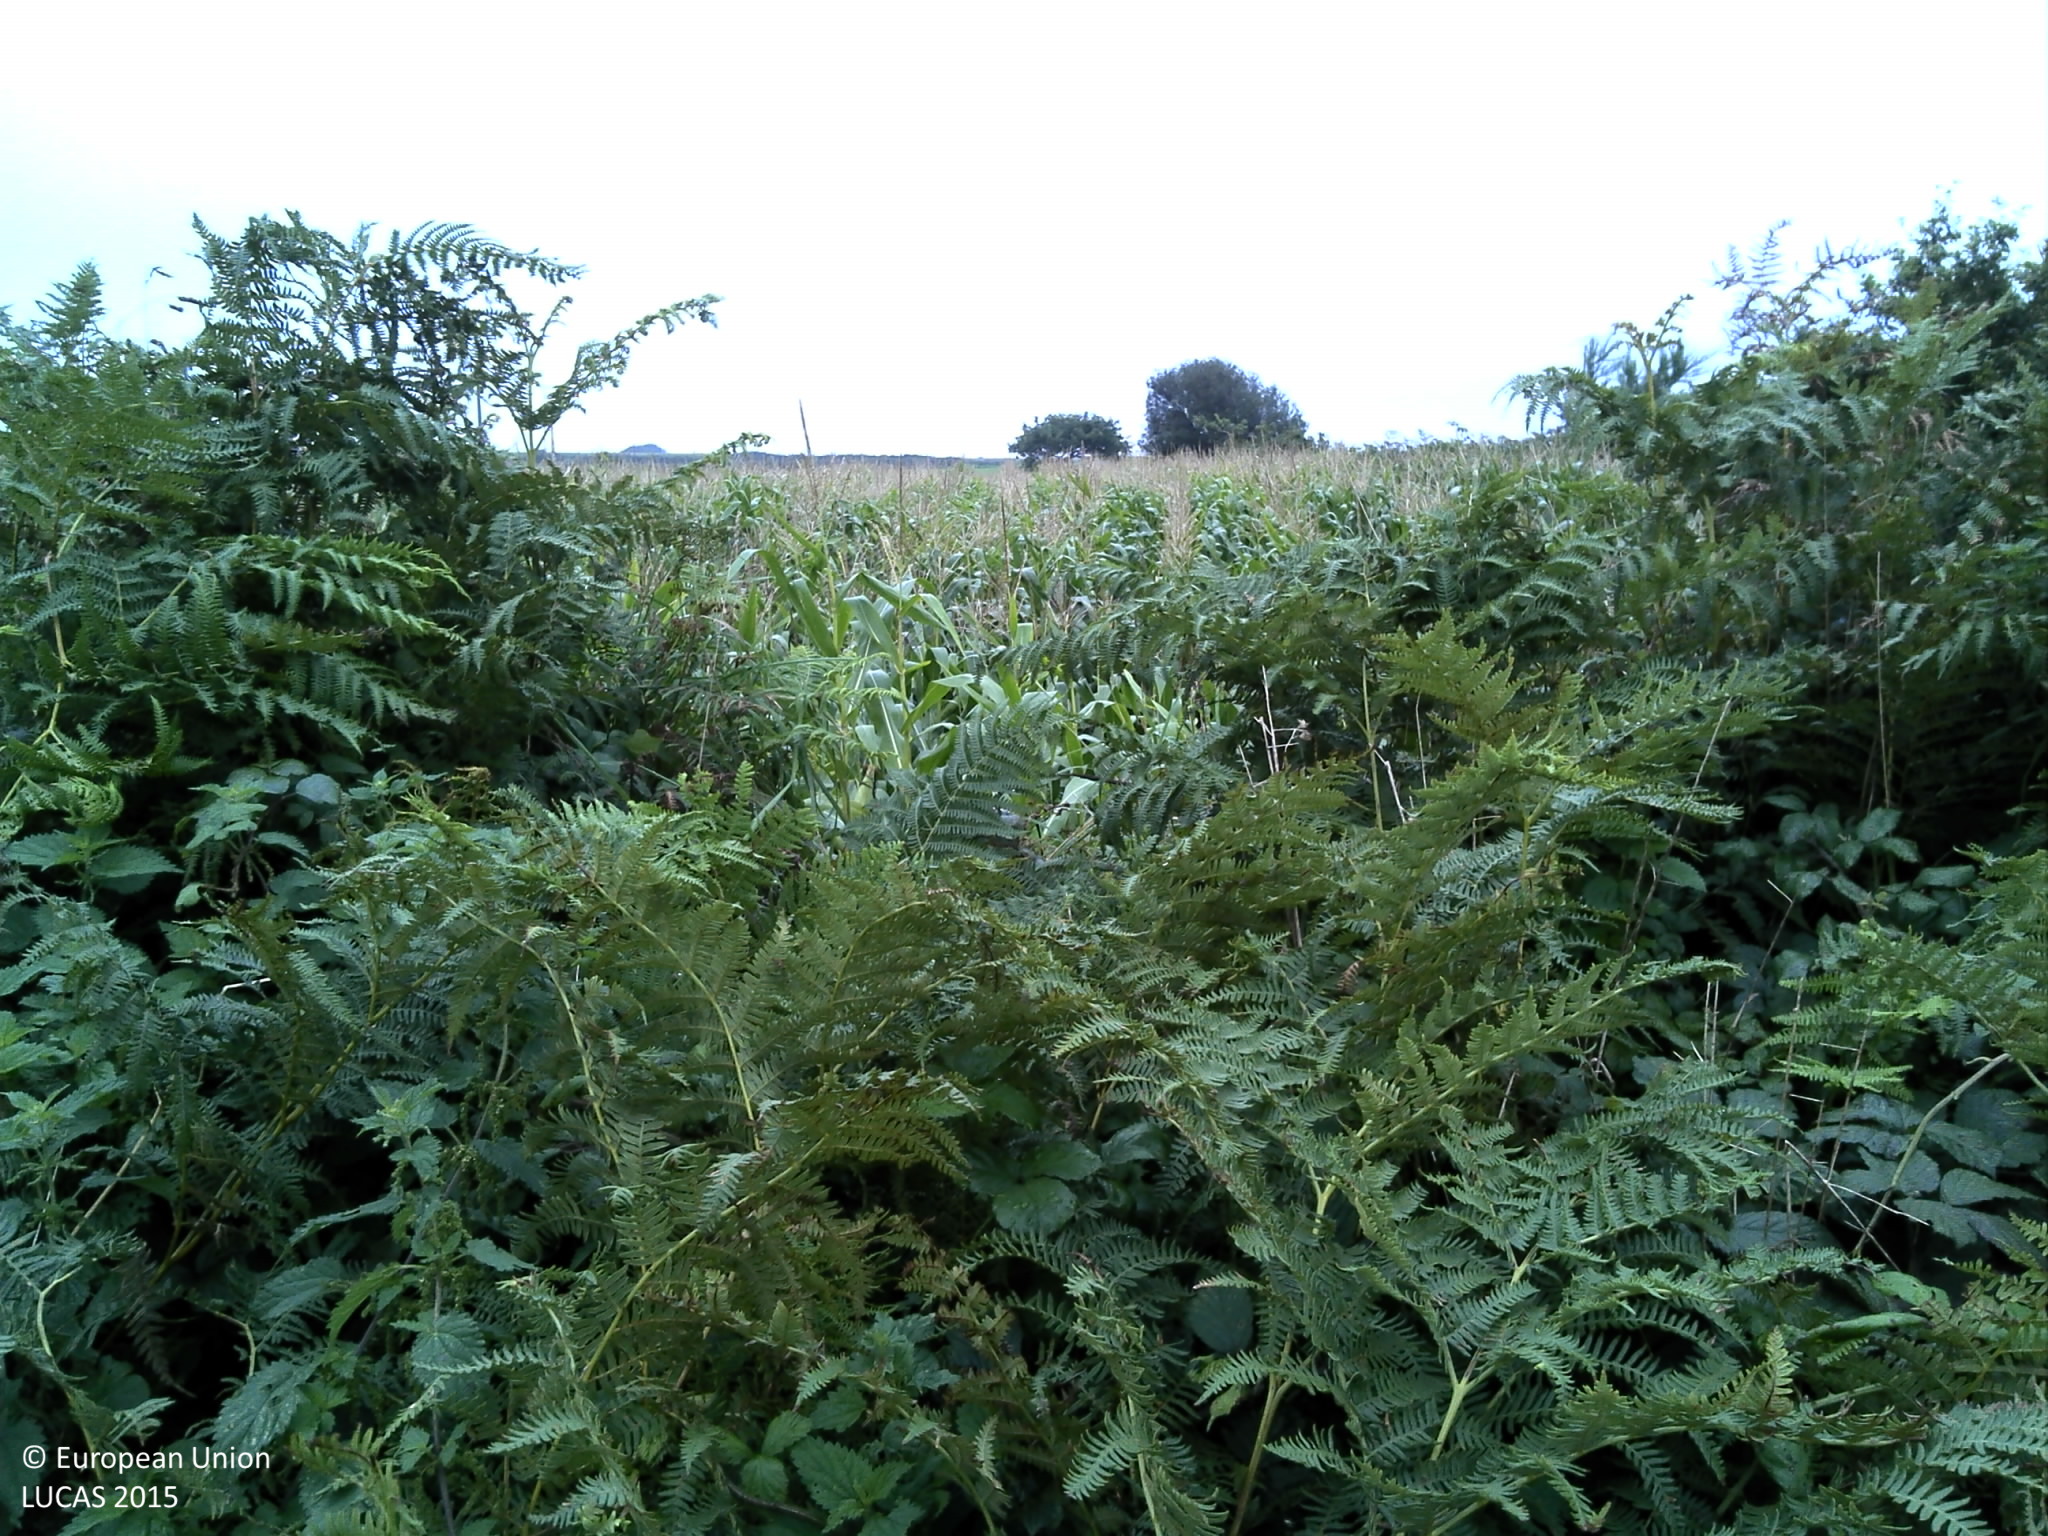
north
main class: Cropland
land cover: Maize
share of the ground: > 75 %
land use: Agriculture (excluding fallow land and kitchen gardens)
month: August
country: FR
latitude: 48.6085
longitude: -4.2399
